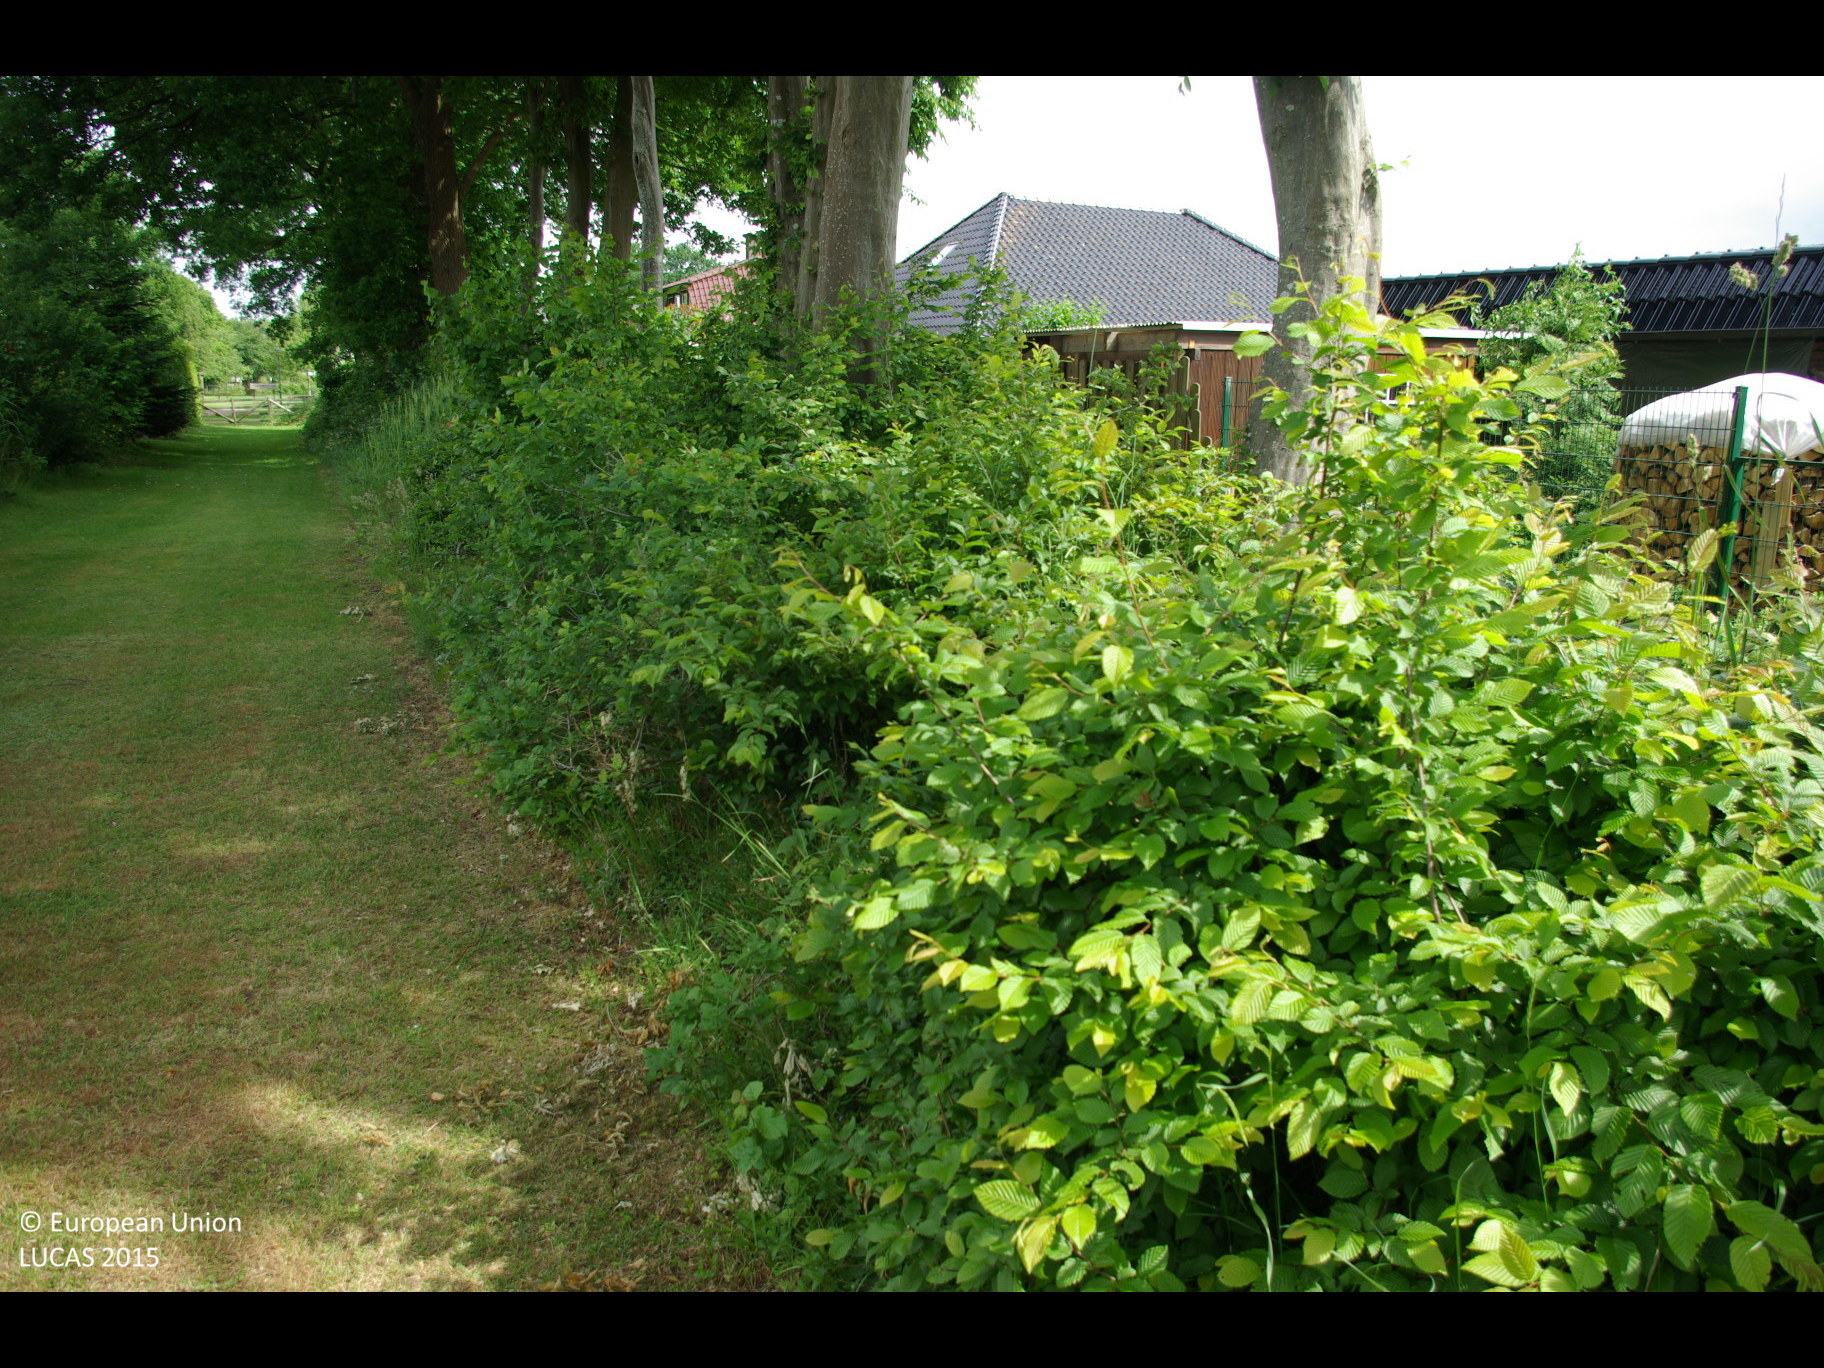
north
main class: Grassland
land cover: Grassland without tree/shrub cover
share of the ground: > 75 %
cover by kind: herbaceous plants 100 %
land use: Residential
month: June
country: DE
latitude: 54.0489
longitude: 9.9542
